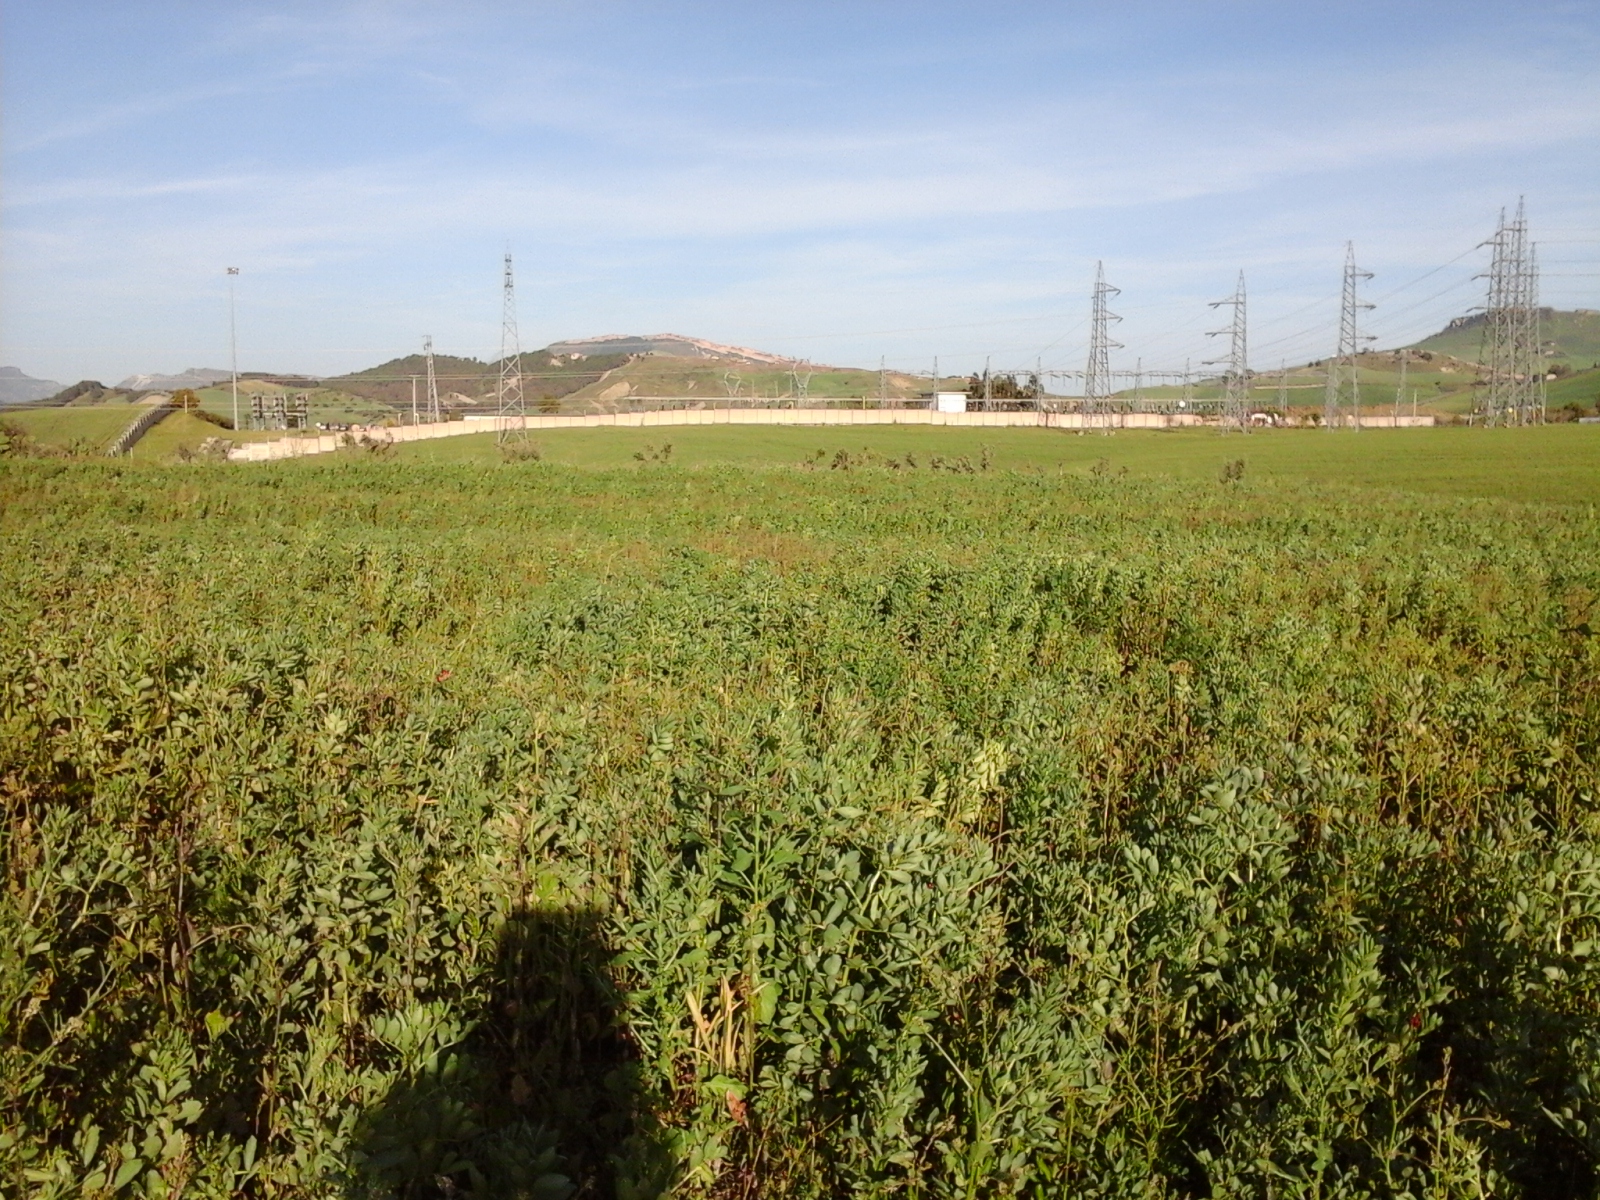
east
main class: Cropland
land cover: Dry pulses
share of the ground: > 75 %
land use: Agriculture (excluding fallow land and kitchen gardens)
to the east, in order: Dry pulses; Olive groves; Dry pulses; Electric lines; Dry pulses; Grass margins; Durum wheat; Electric lines; Durum wheat; Electric lines; Durum wheat
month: May
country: IT
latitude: 37.5329
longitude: 14.0776
